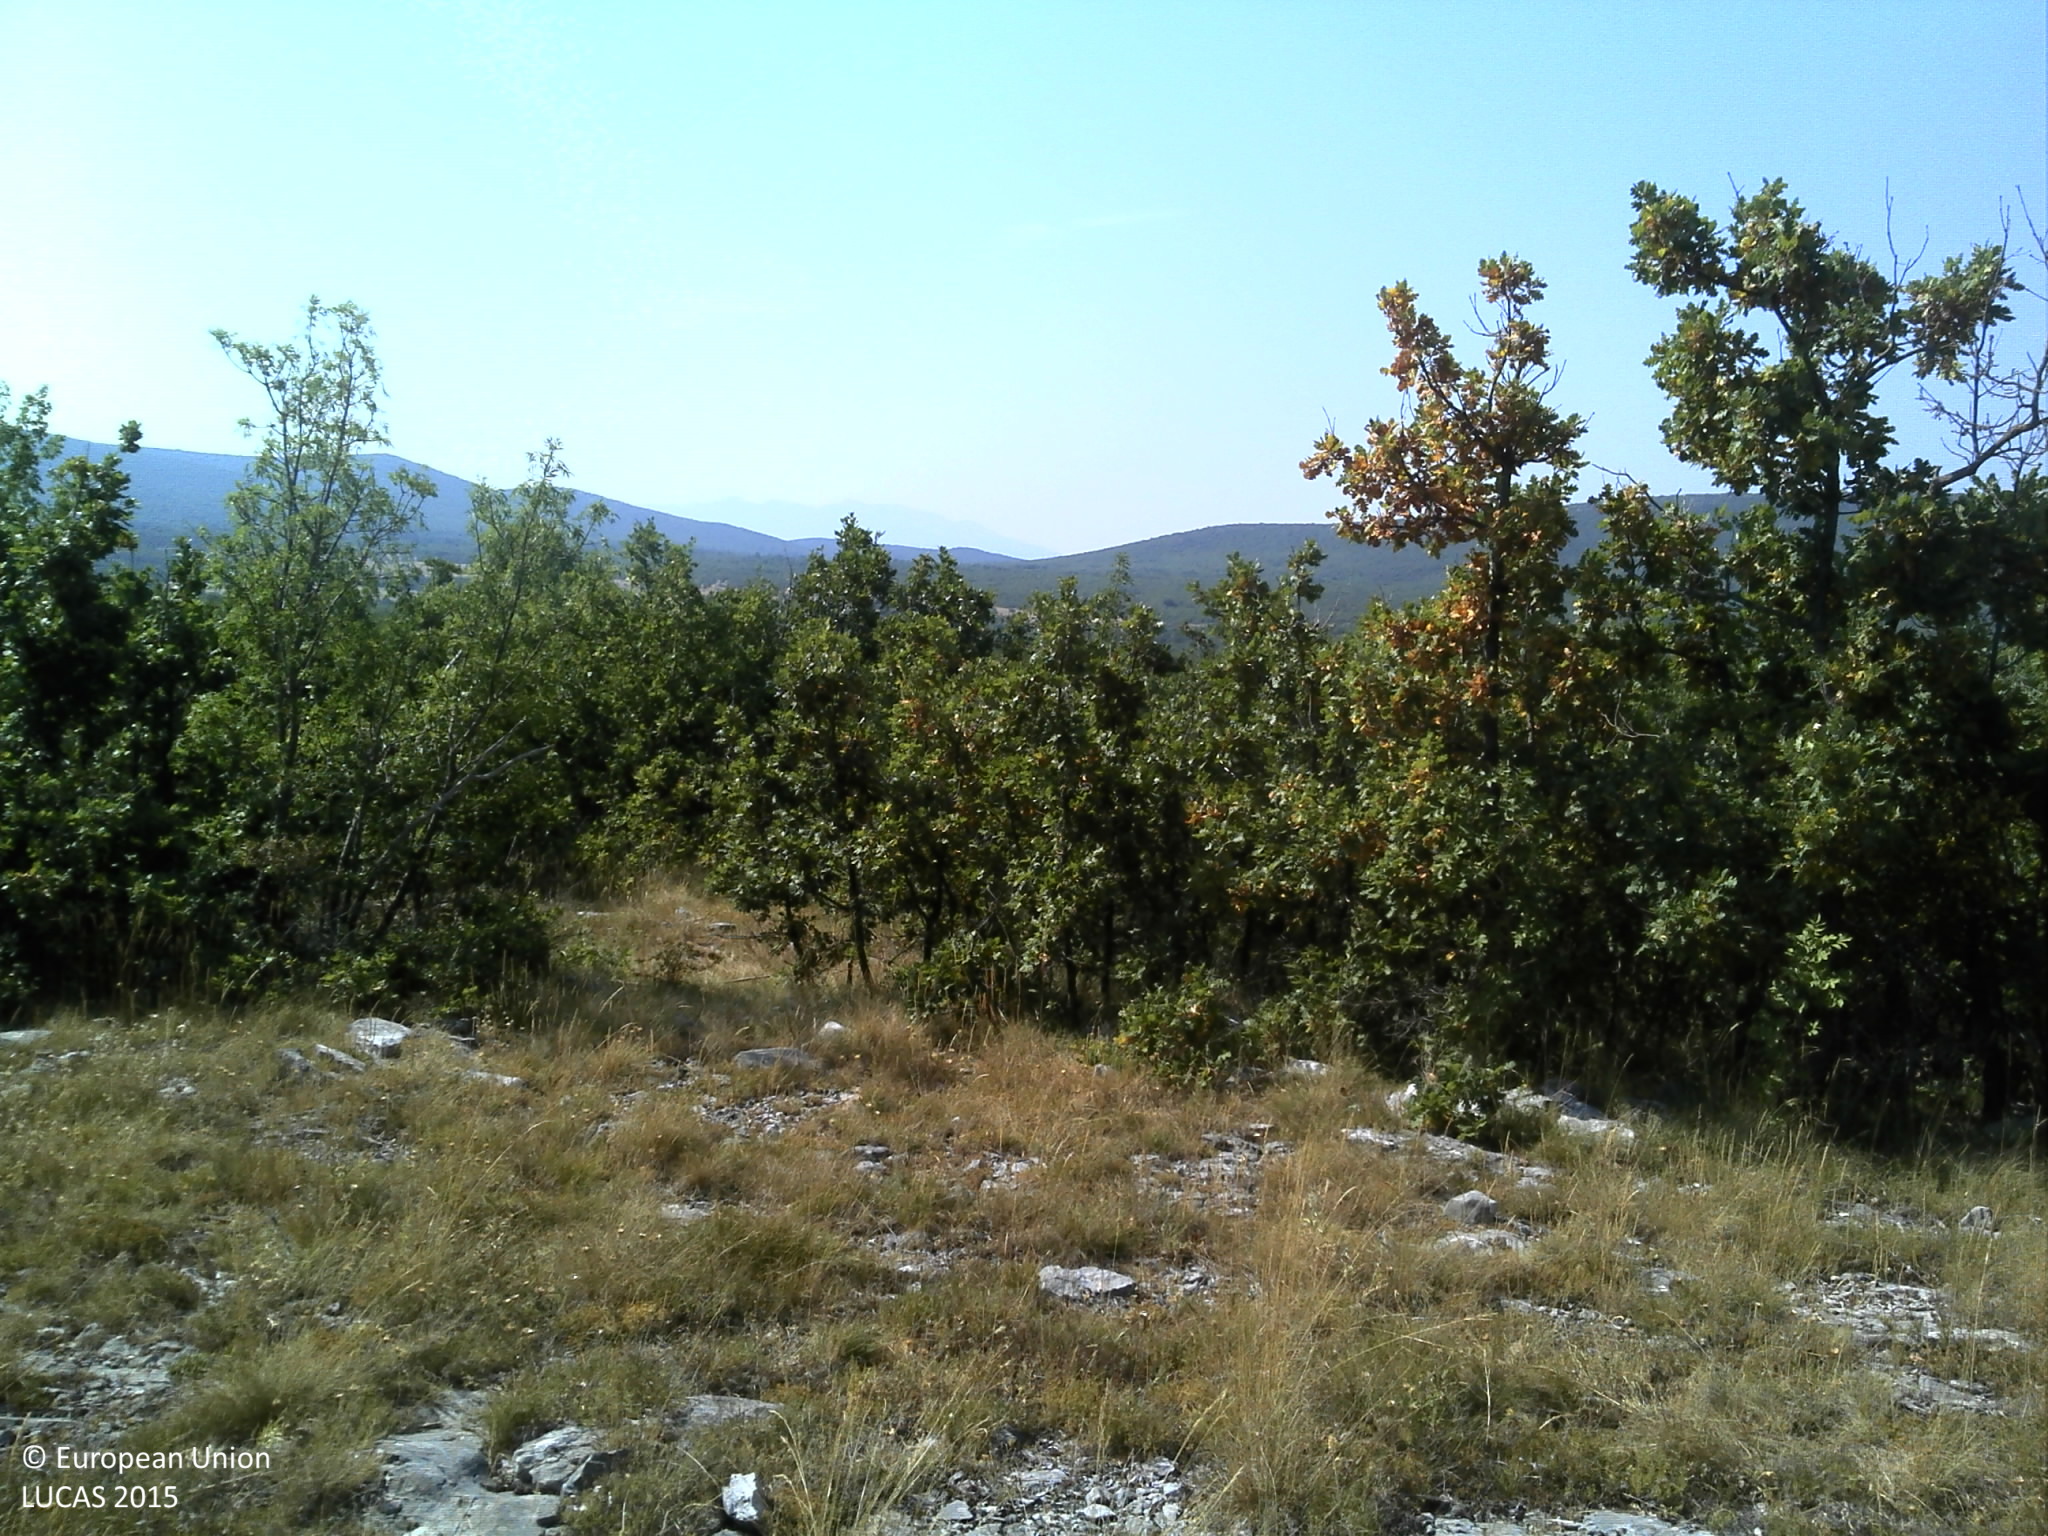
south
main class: Woodland
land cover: Broadleaved woodland
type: thermophilous deciduous forest
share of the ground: 50 - 75 %
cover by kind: broadleaved forest trees 55 %, consolidated bare surface 20 %, shrubs 15 %, herbaceous plants 10 %
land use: Semi-natural and natural areas not in use
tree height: > 5 m
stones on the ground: 10 - 25 %
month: July
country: HR
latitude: 43.5947
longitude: 16.9162
